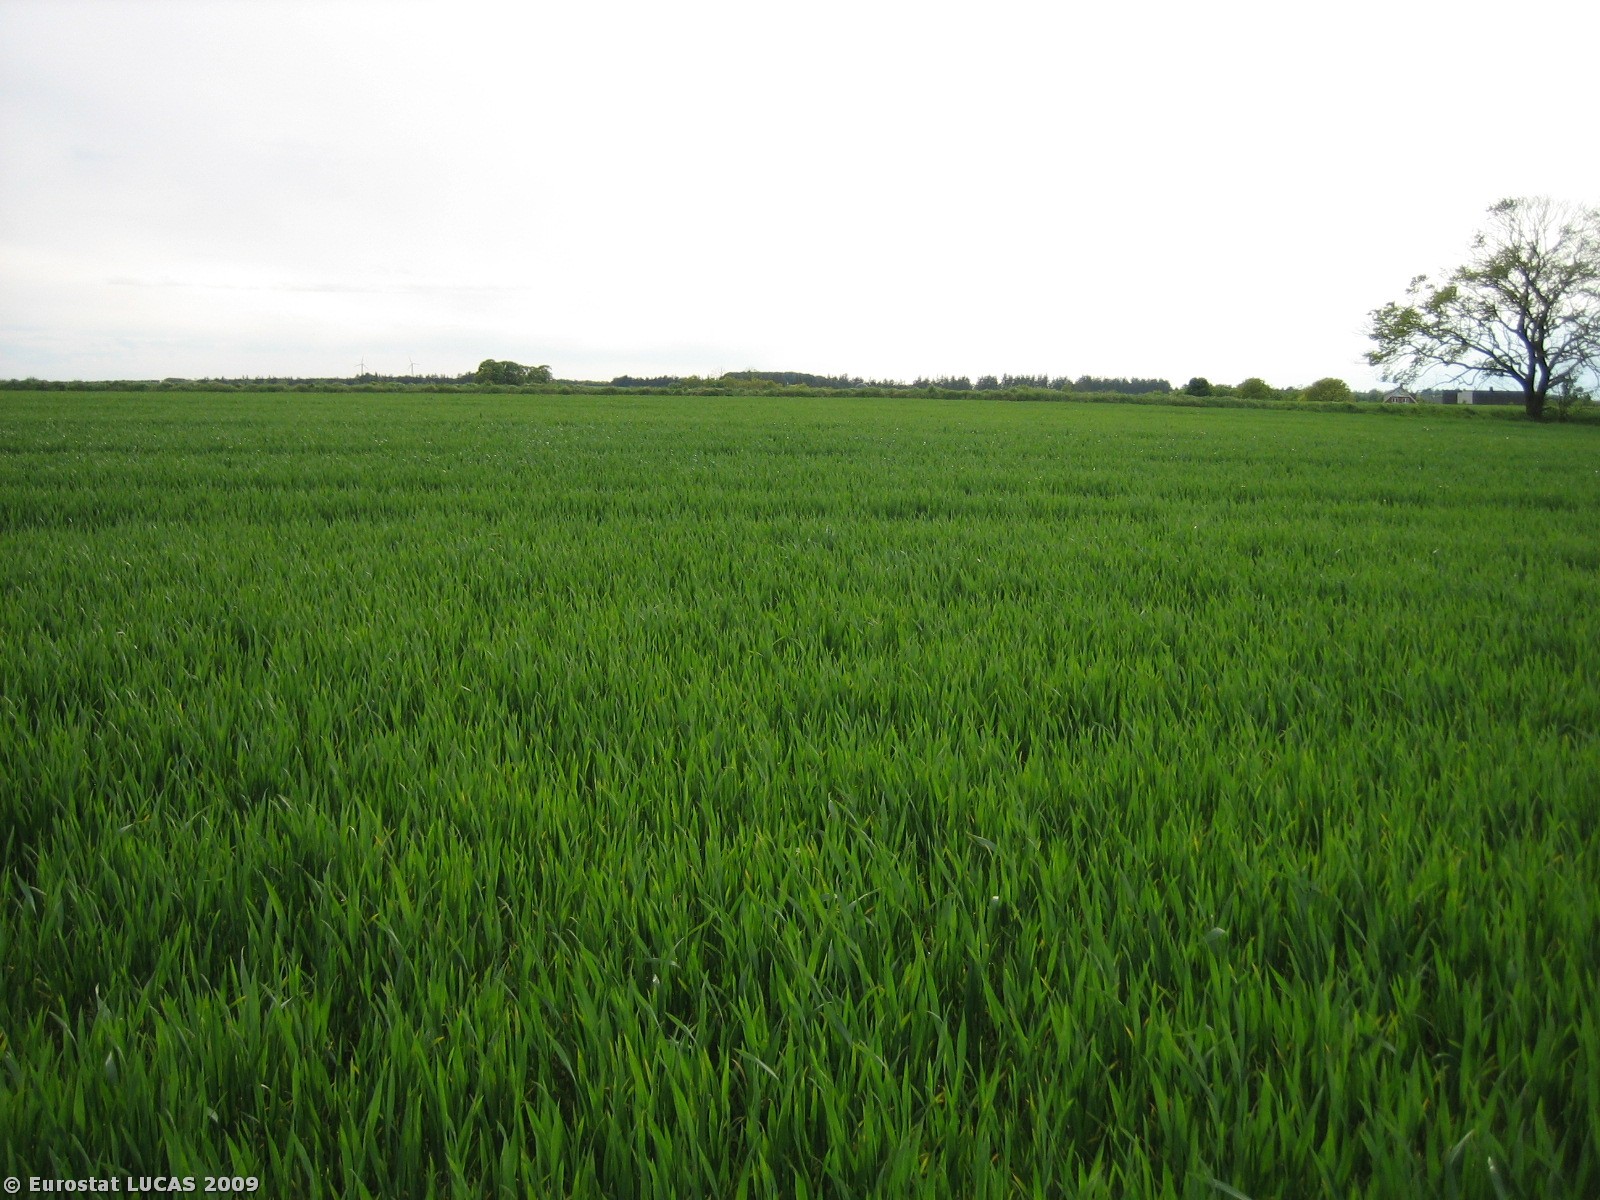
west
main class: Cropland
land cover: Common wheat
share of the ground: > 75 %
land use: Agriculture (excluding fallow land and kitchen gardens)
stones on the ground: < 10 %
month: May
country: DK
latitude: 56.1247
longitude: 8.4734
